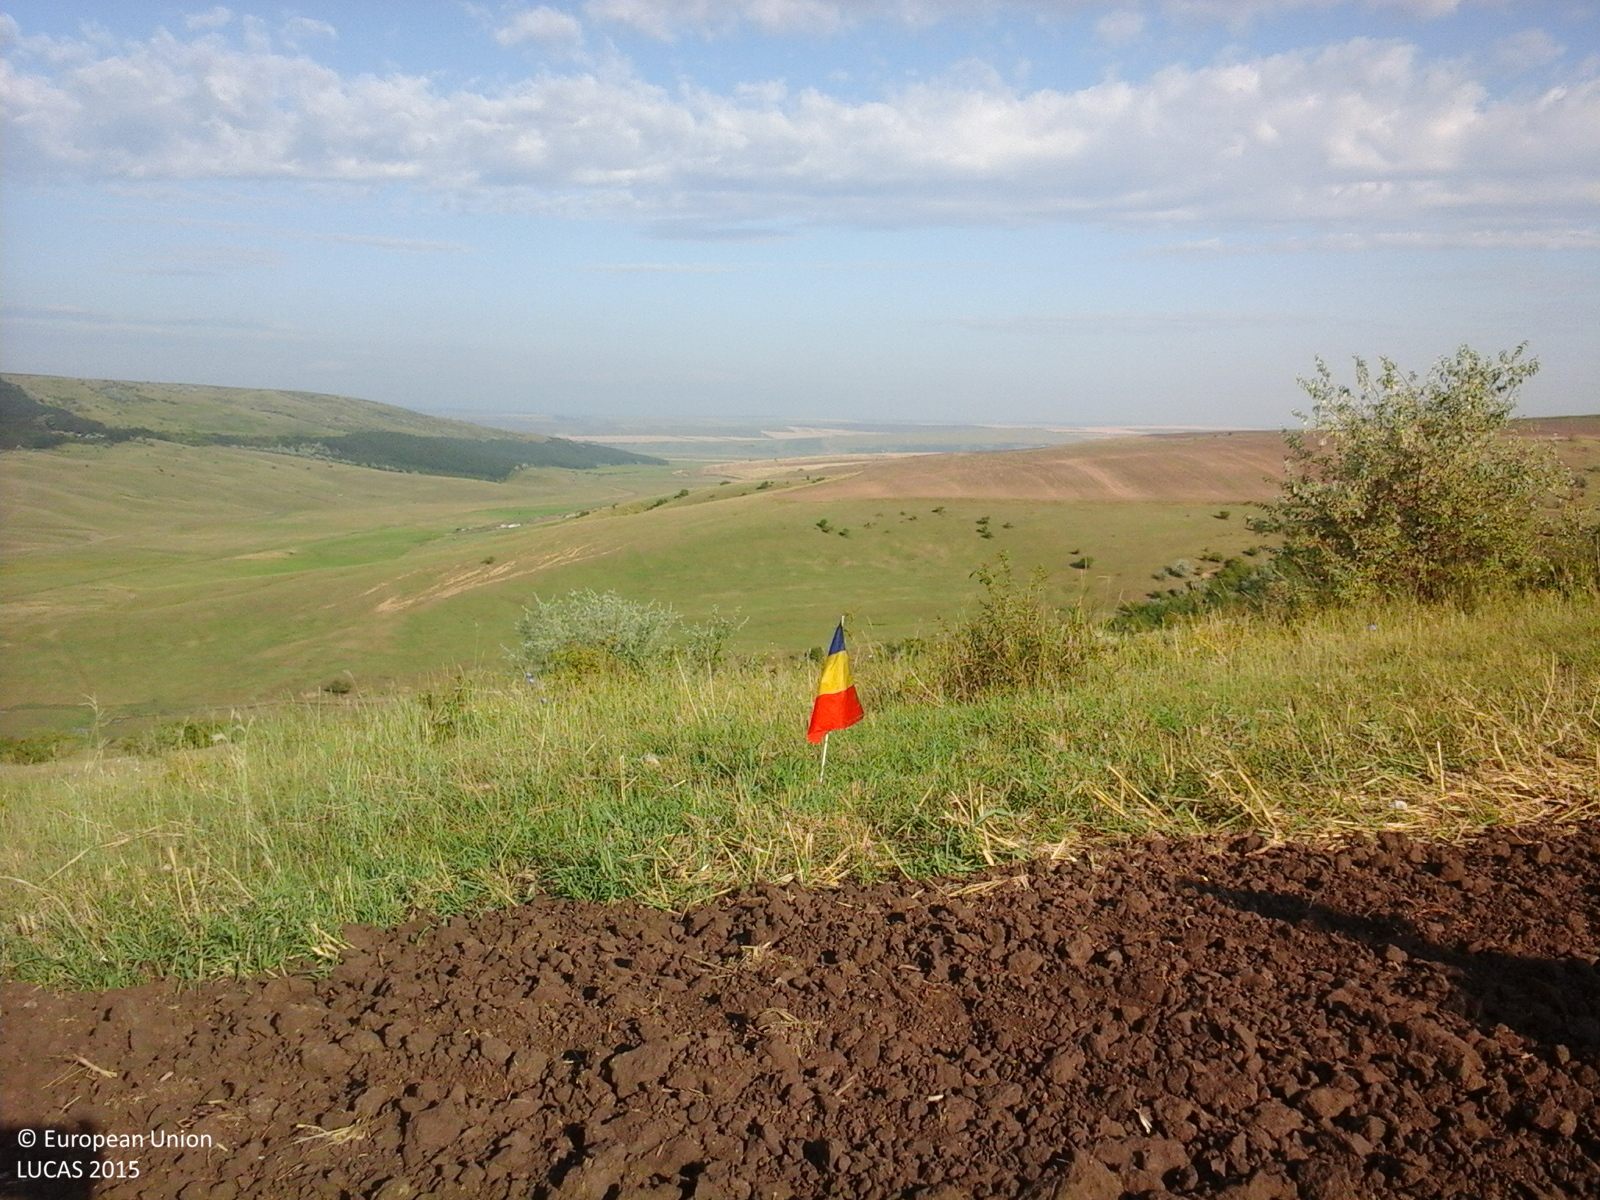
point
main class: Grassland
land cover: Grassland without tree/shrub cover
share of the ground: > 75 %
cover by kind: herbaceous plants 100 %
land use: Agriculture (excluding fallow land and kitchen gardens)
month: July
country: RO
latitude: 46.2787
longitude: 27.8071
